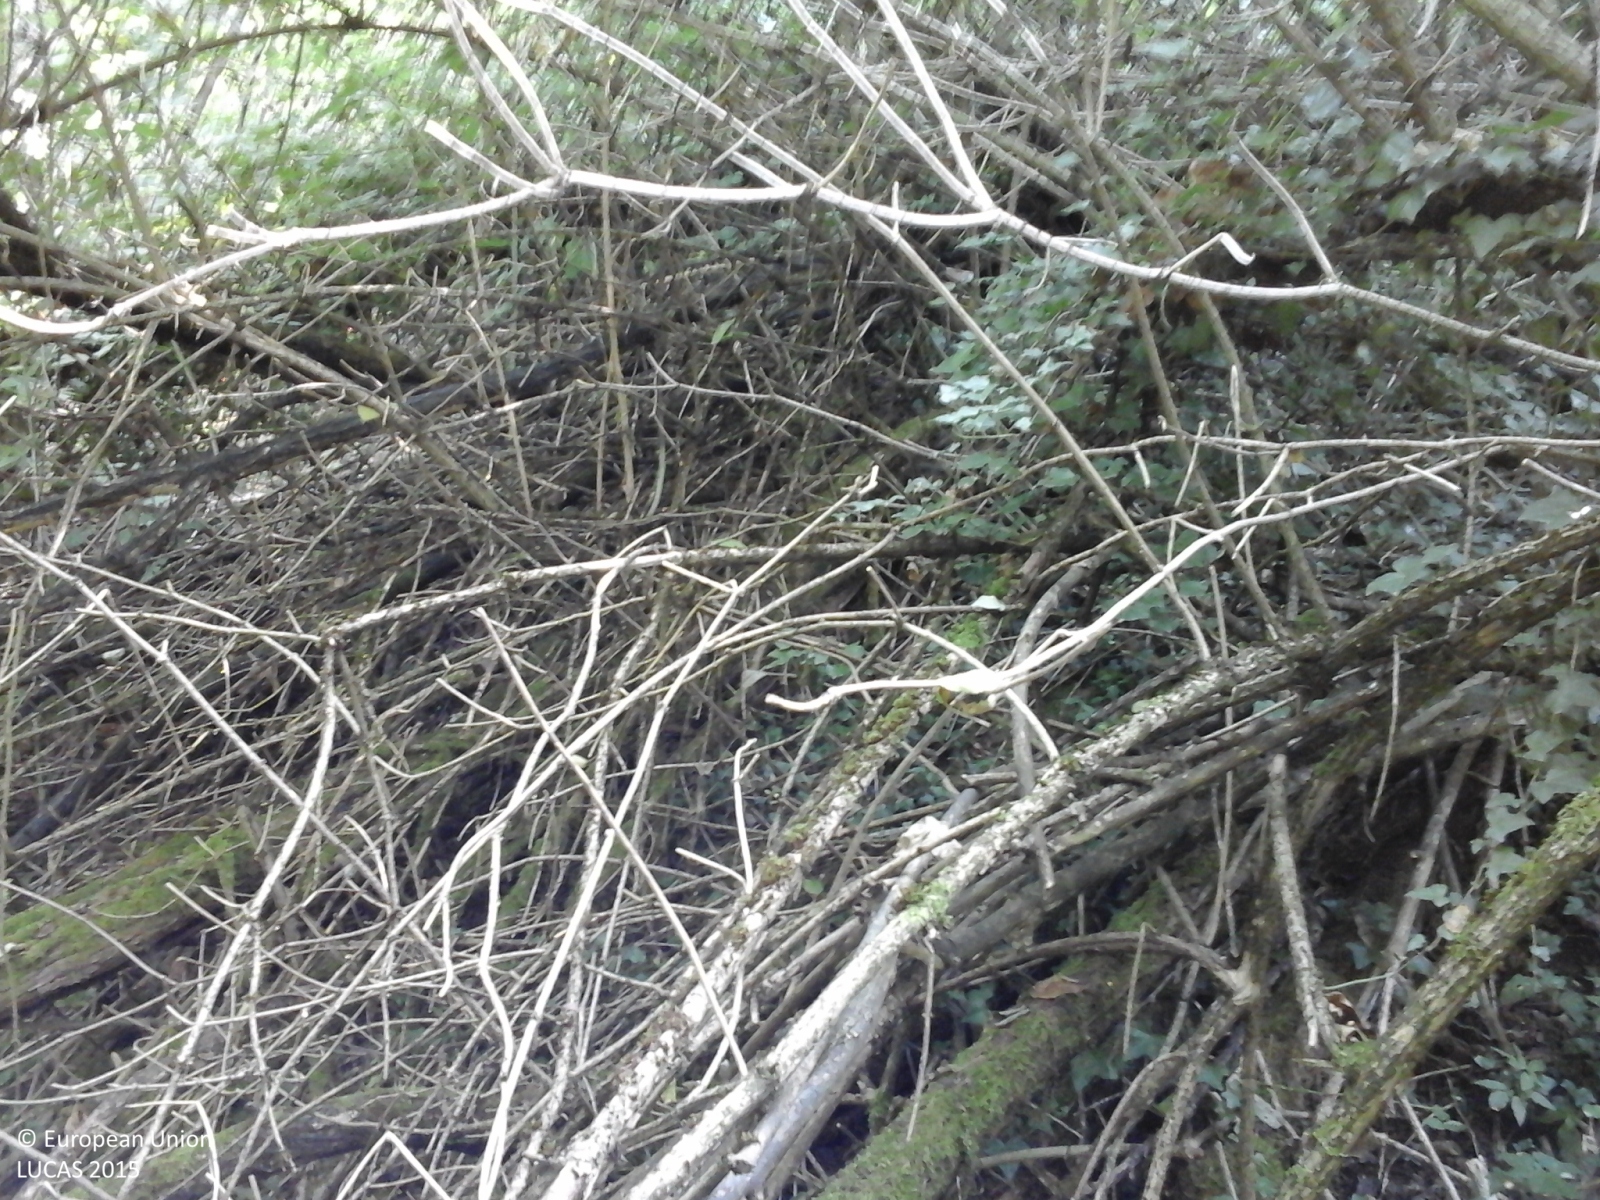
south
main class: Woodland
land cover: Broadleaved woodland
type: thermophilous deciduous forest
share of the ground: > 75 %
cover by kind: broadleaved forest trees 100 %
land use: Semi-natural and natural areas not in use
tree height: > 5 m
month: July
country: IT
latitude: 44.6861
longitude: 8.7787
